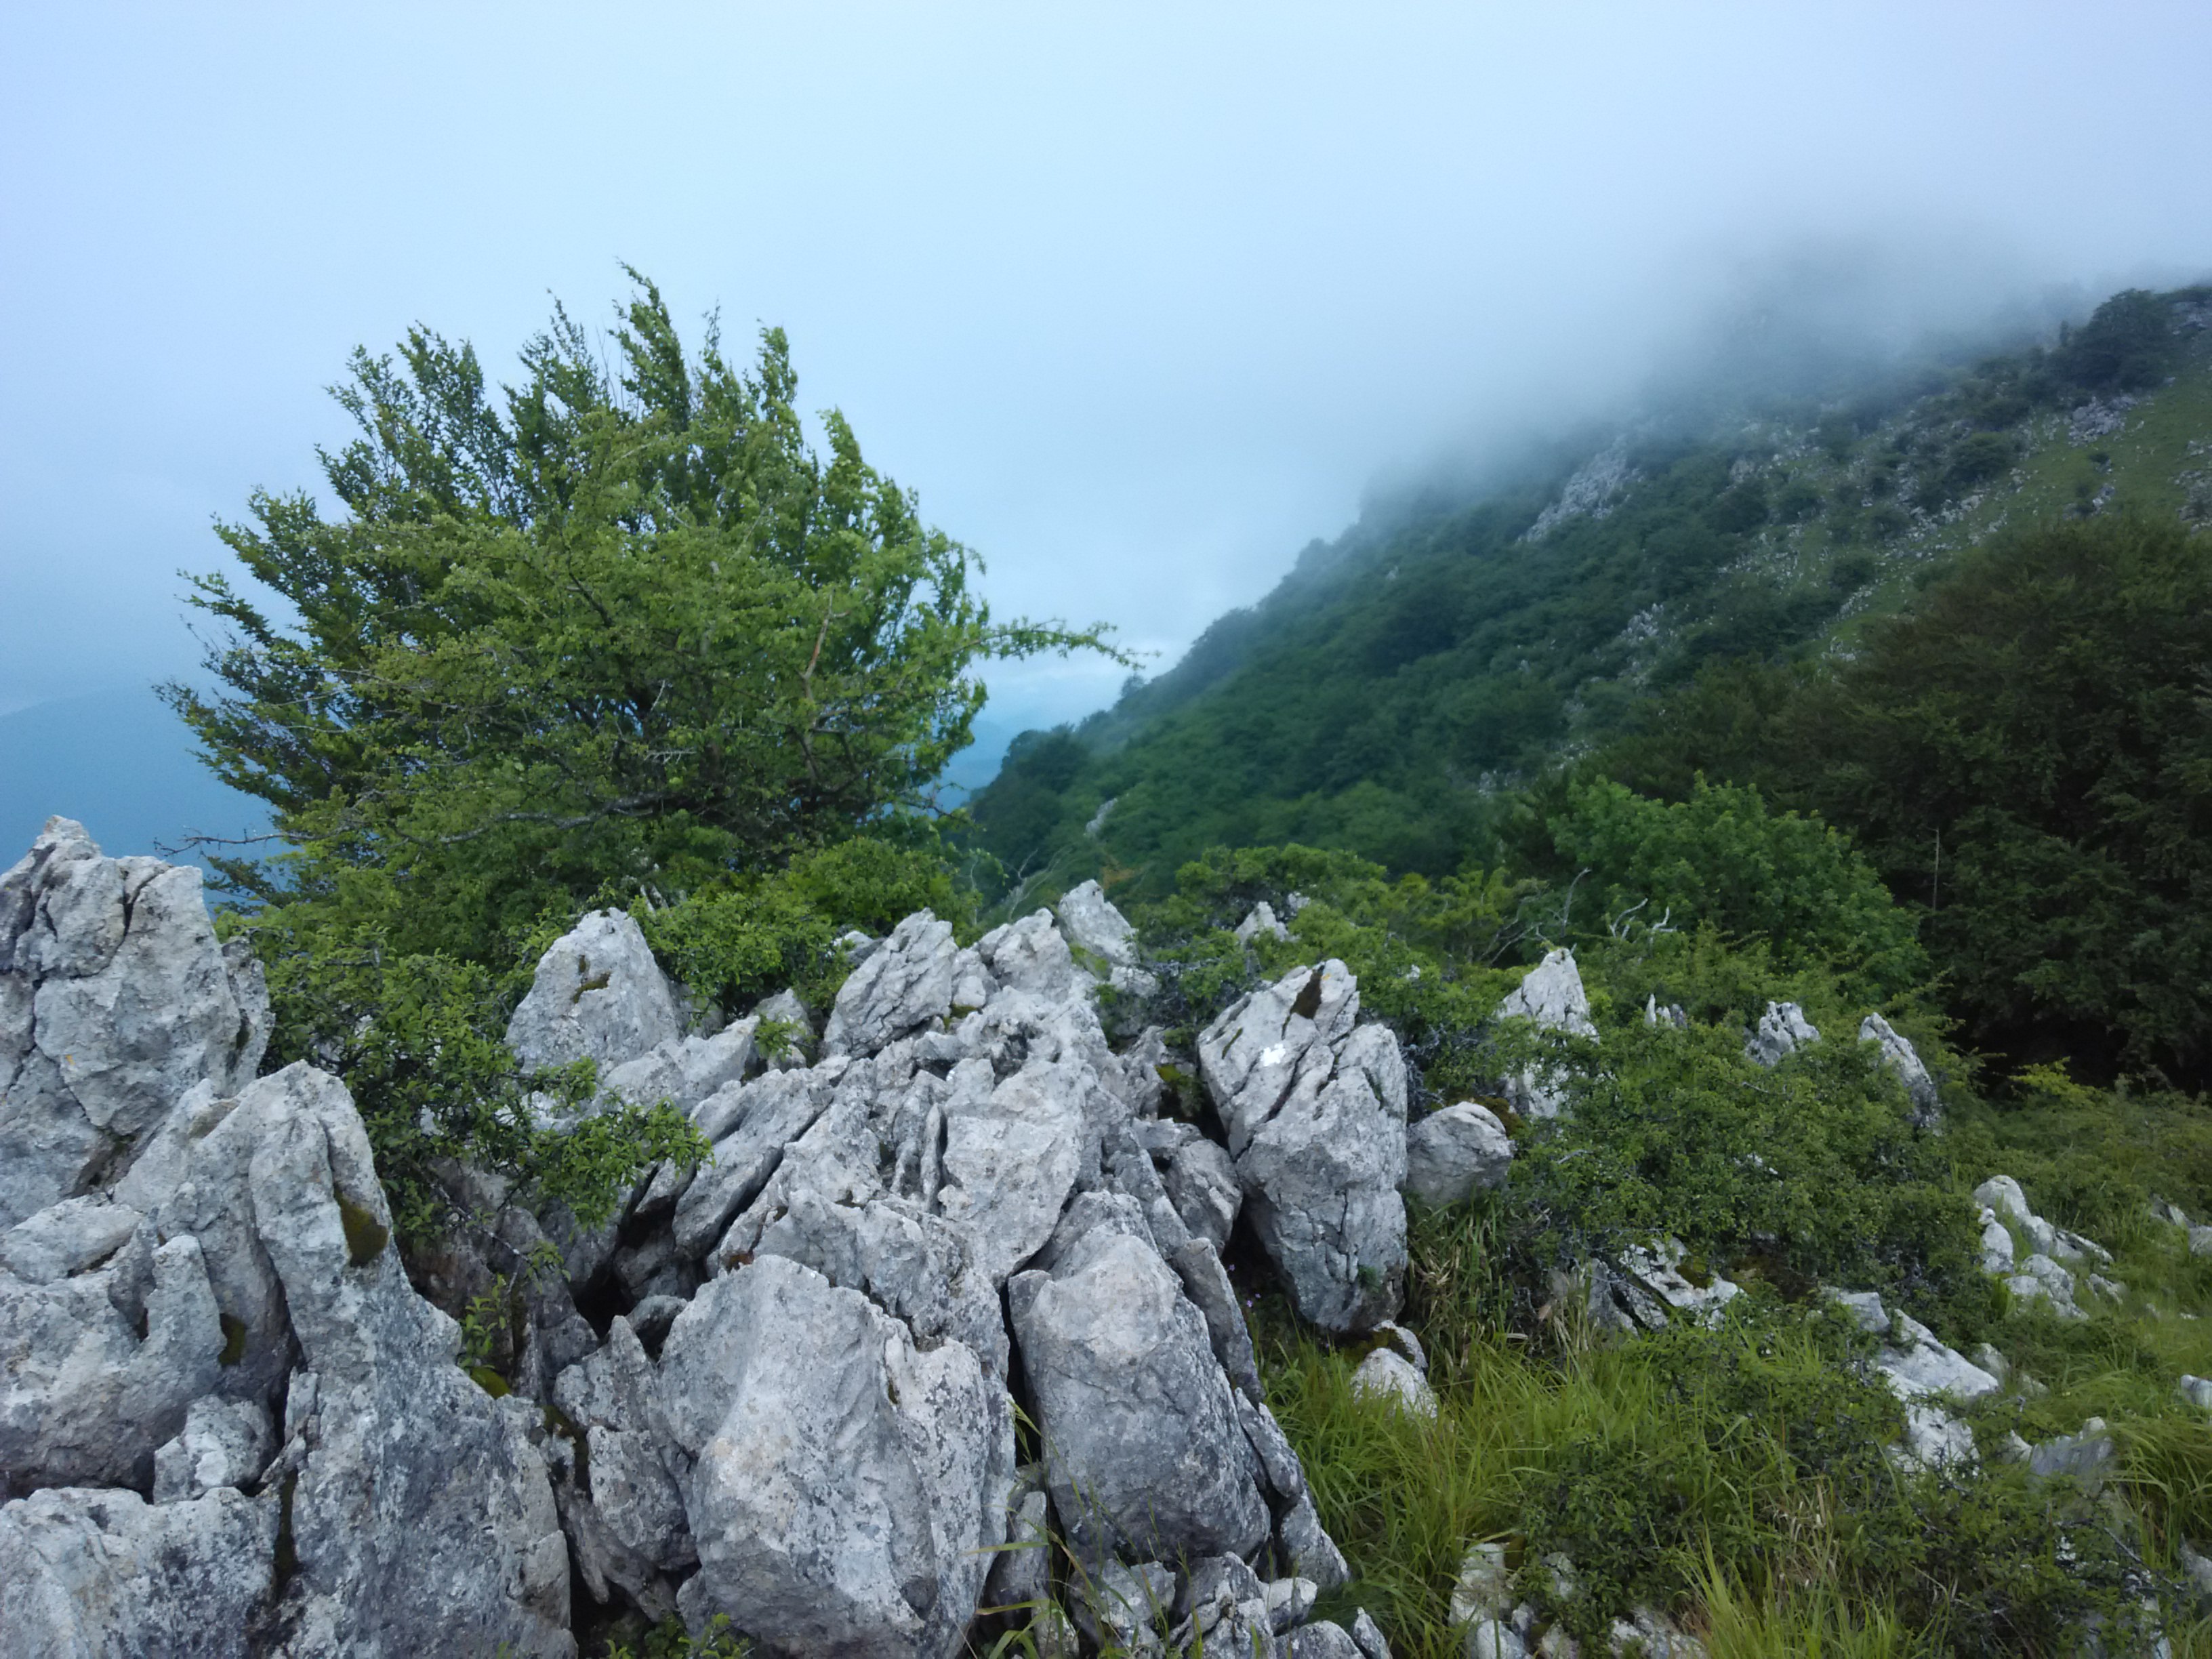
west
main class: Grassland
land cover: Grassland with sparse tree/shrub cover
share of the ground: 25 - 50 %
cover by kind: consolidated bare surface 50 %, herbaceous plants 40 %, broadleaved forest trees 5 %, shrubs 5 %
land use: Agriculture (excluding fallow land and kitchen gardens)
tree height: < 5 m
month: June
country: ES
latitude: 43.1971
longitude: -2.2944
